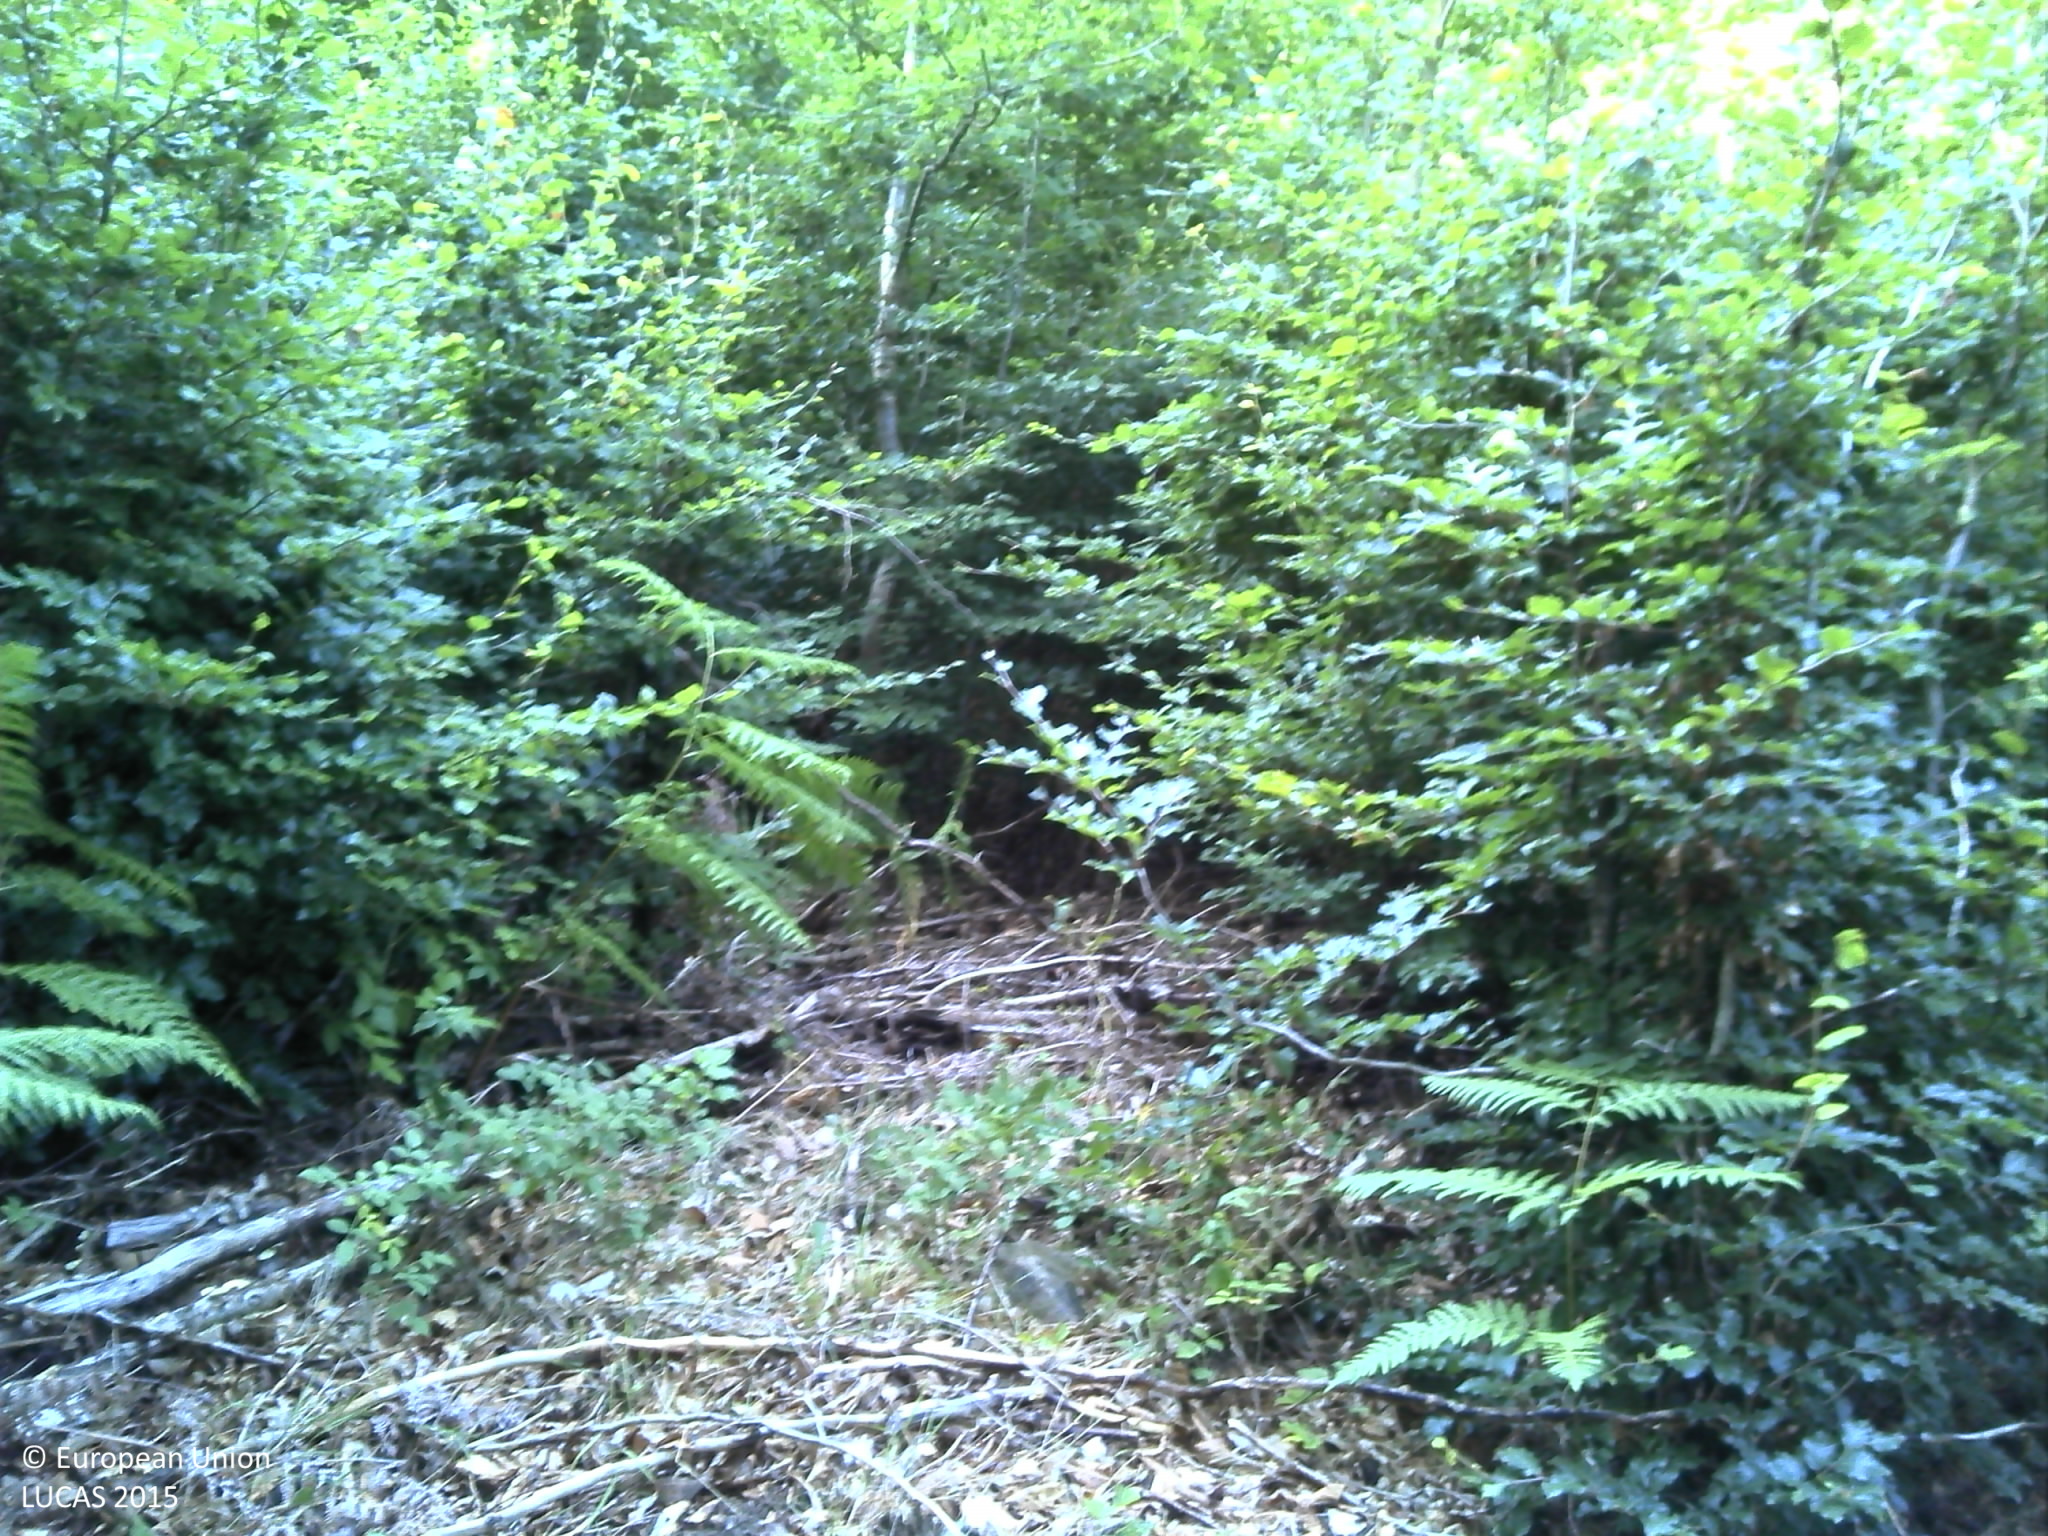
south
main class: Woodland
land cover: Broadleaved woodland
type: beech forest
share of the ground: > 75 %
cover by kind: broadleaved forest trees 90 %, herbaceous plants 5 %, unconsolidated bare surface 5 %
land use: Forestry
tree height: > 5 m
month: July
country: FR
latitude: 48.0294
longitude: 6.1251
